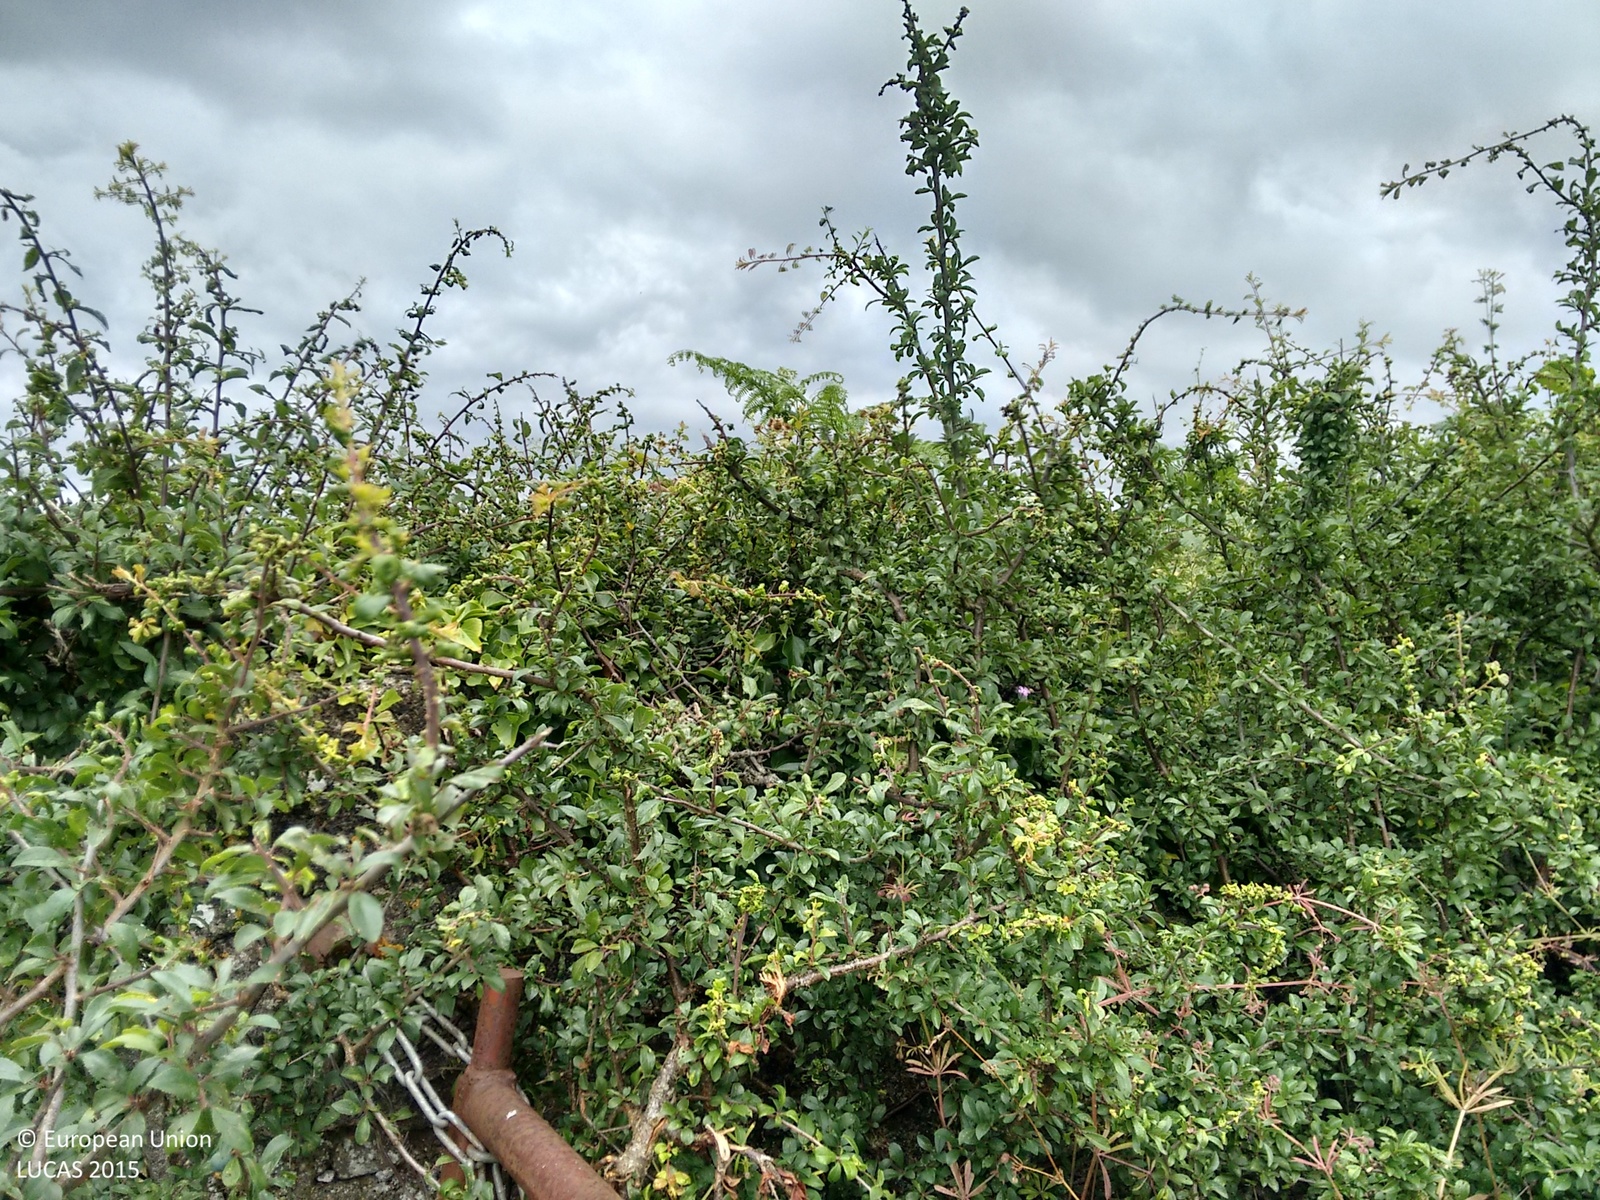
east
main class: Grassland
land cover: Grassland without tree/shrub cover
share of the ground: > 75 %
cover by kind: herbaceous plants 100 %
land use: Agriculture (excluding fallow land and kitchen gardens)
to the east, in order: Grassland without tree/shrub cover; Abandoned hedges; Ditches and canals; Barley; Grassland without tree/shrub cover
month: July
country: IE
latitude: 52.7164
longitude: -7.2795
